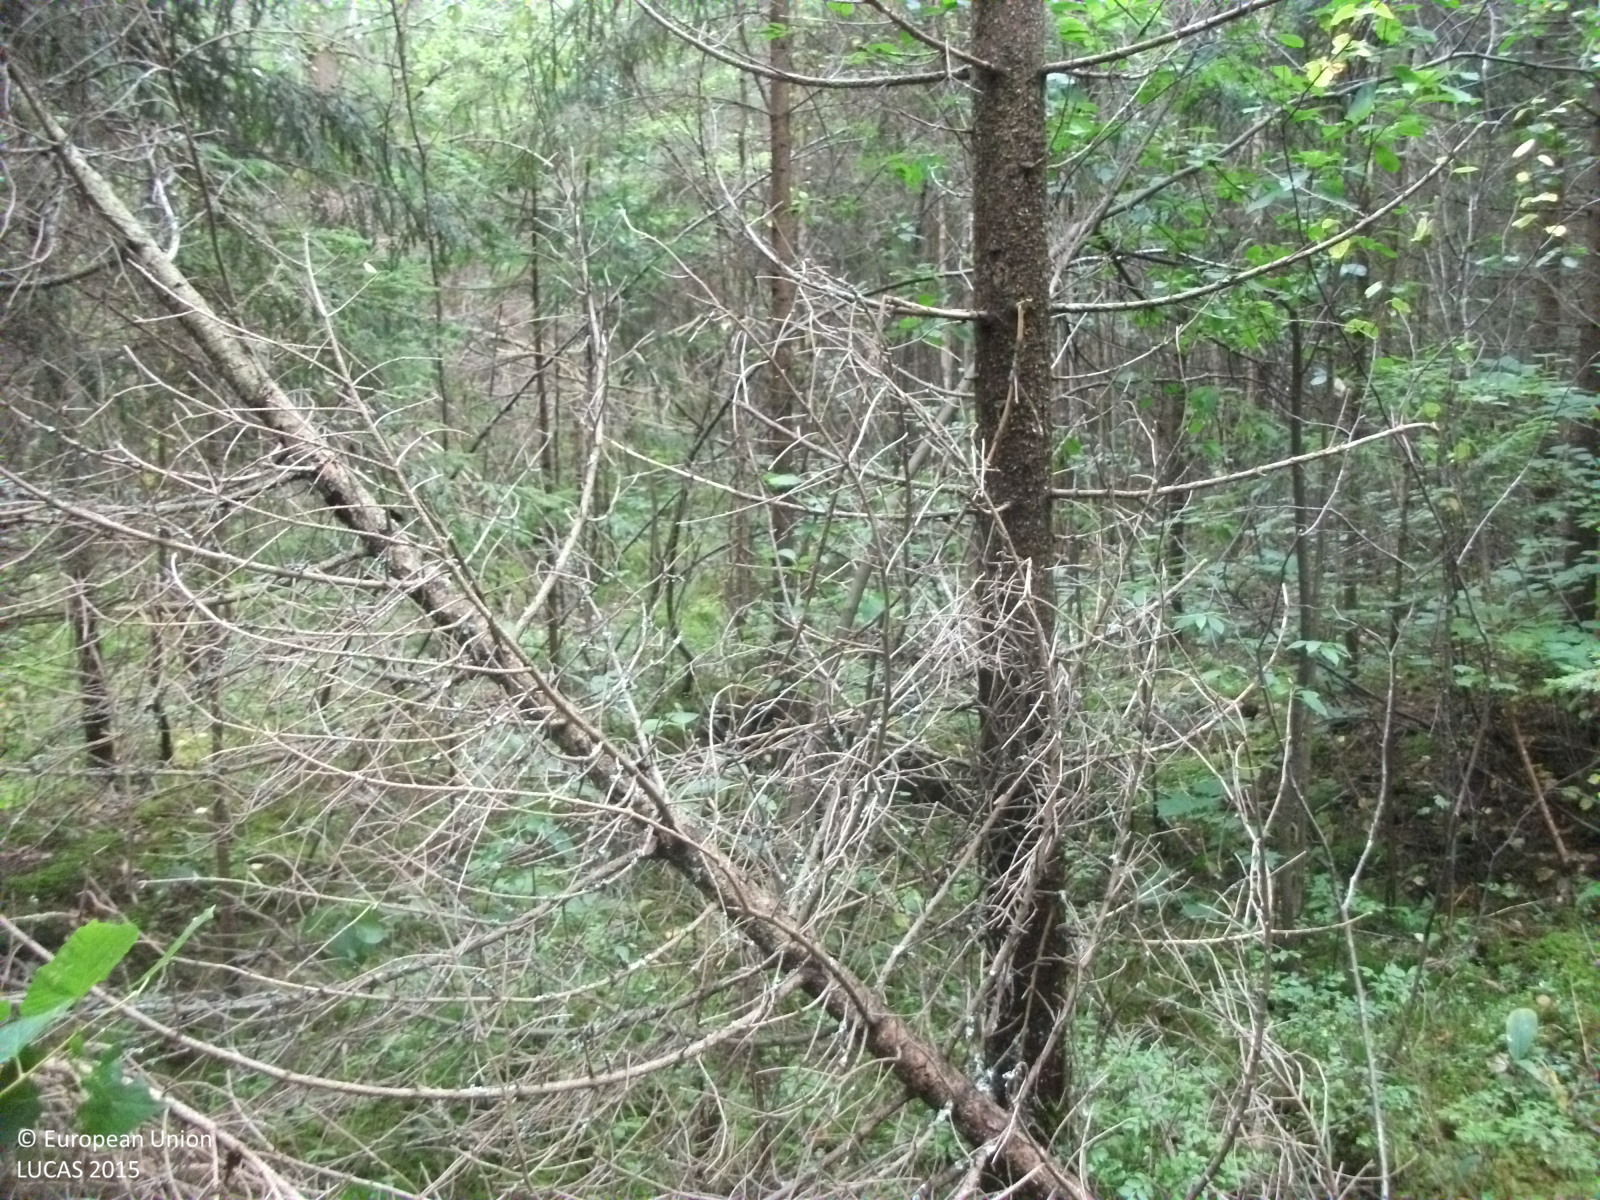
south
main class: Woodland
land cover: Spruce dominated coniferous woodland
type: hemiboreal forest and nemoral coniferous forest and mixed broadleaved-coniferous forest
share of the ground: > 75 %
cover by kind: coniferous forest trees 90 %, broadleaved forest trees 5 %, shrubs 5 %
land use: Forestry
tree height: > 5 m
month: September
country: LV
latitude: 57.6034
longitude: 24.3962
